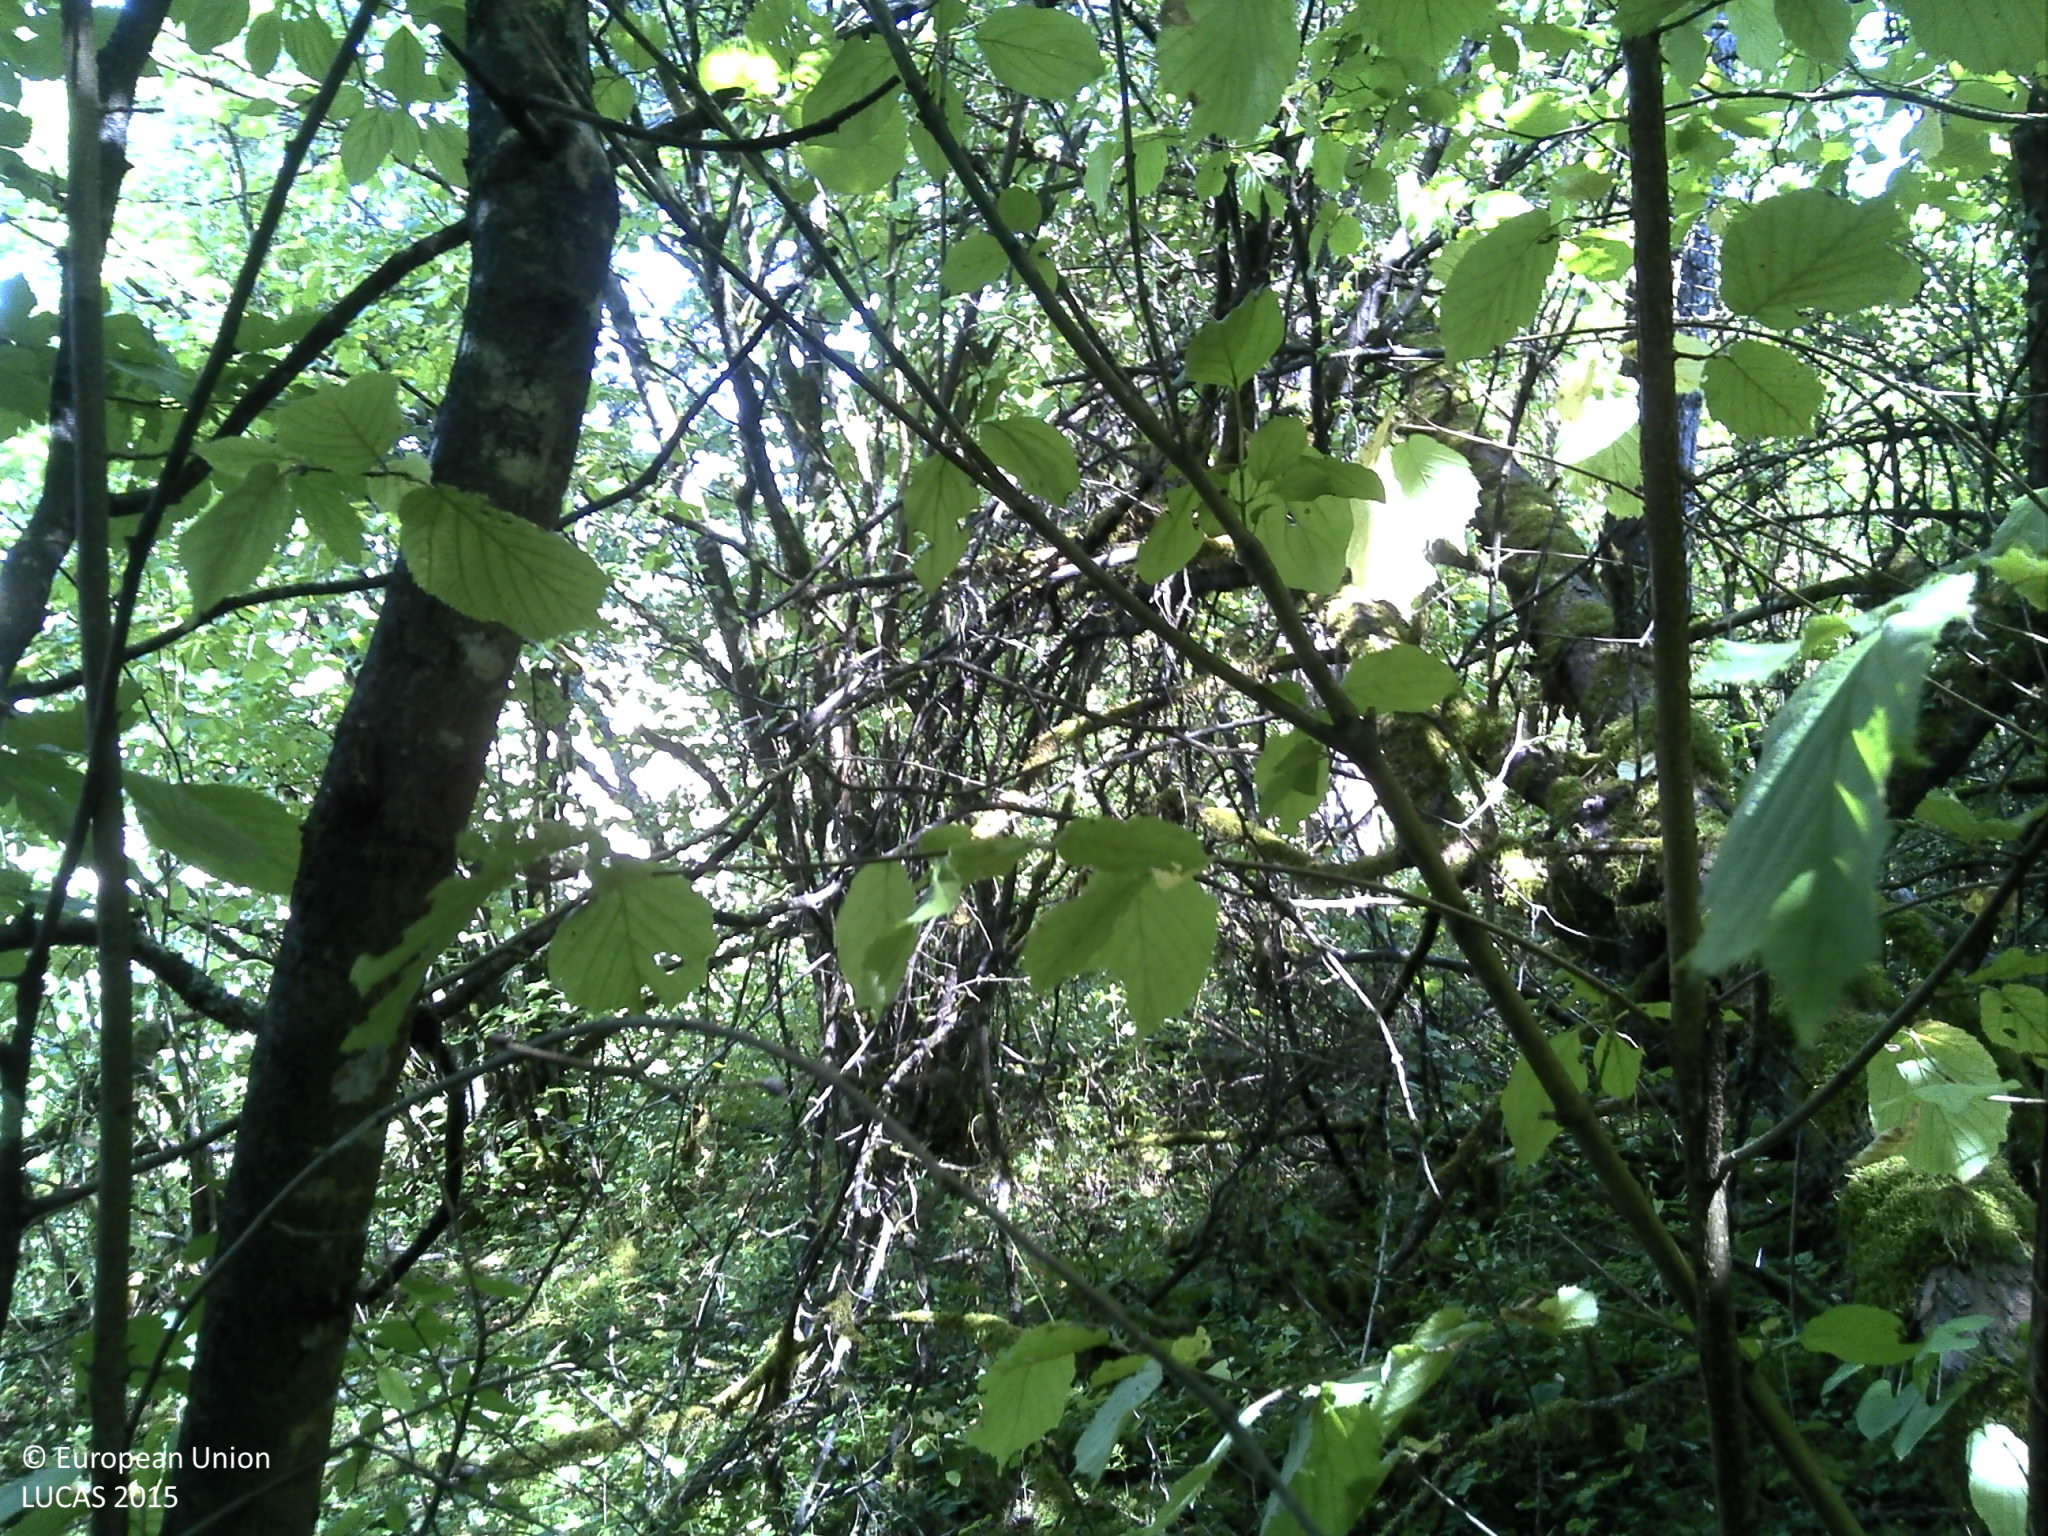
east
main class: Woodland
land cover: Broadleaved woodland
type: mesophytic deciduous forest
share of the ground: > 75 %
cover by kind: broadleaved forest trees 90 %, coniferous forest trees 5 %, herbaceous plants 5 %
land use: Semi-natural and natural areas not in use
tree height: > 5 m
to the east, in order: Broadleaved woodland; Grassland without tree/shrub cover; Electric lines; Grassland without tree/shrub cover
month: August
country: FR
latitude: 48.9121
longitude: 4.7988
